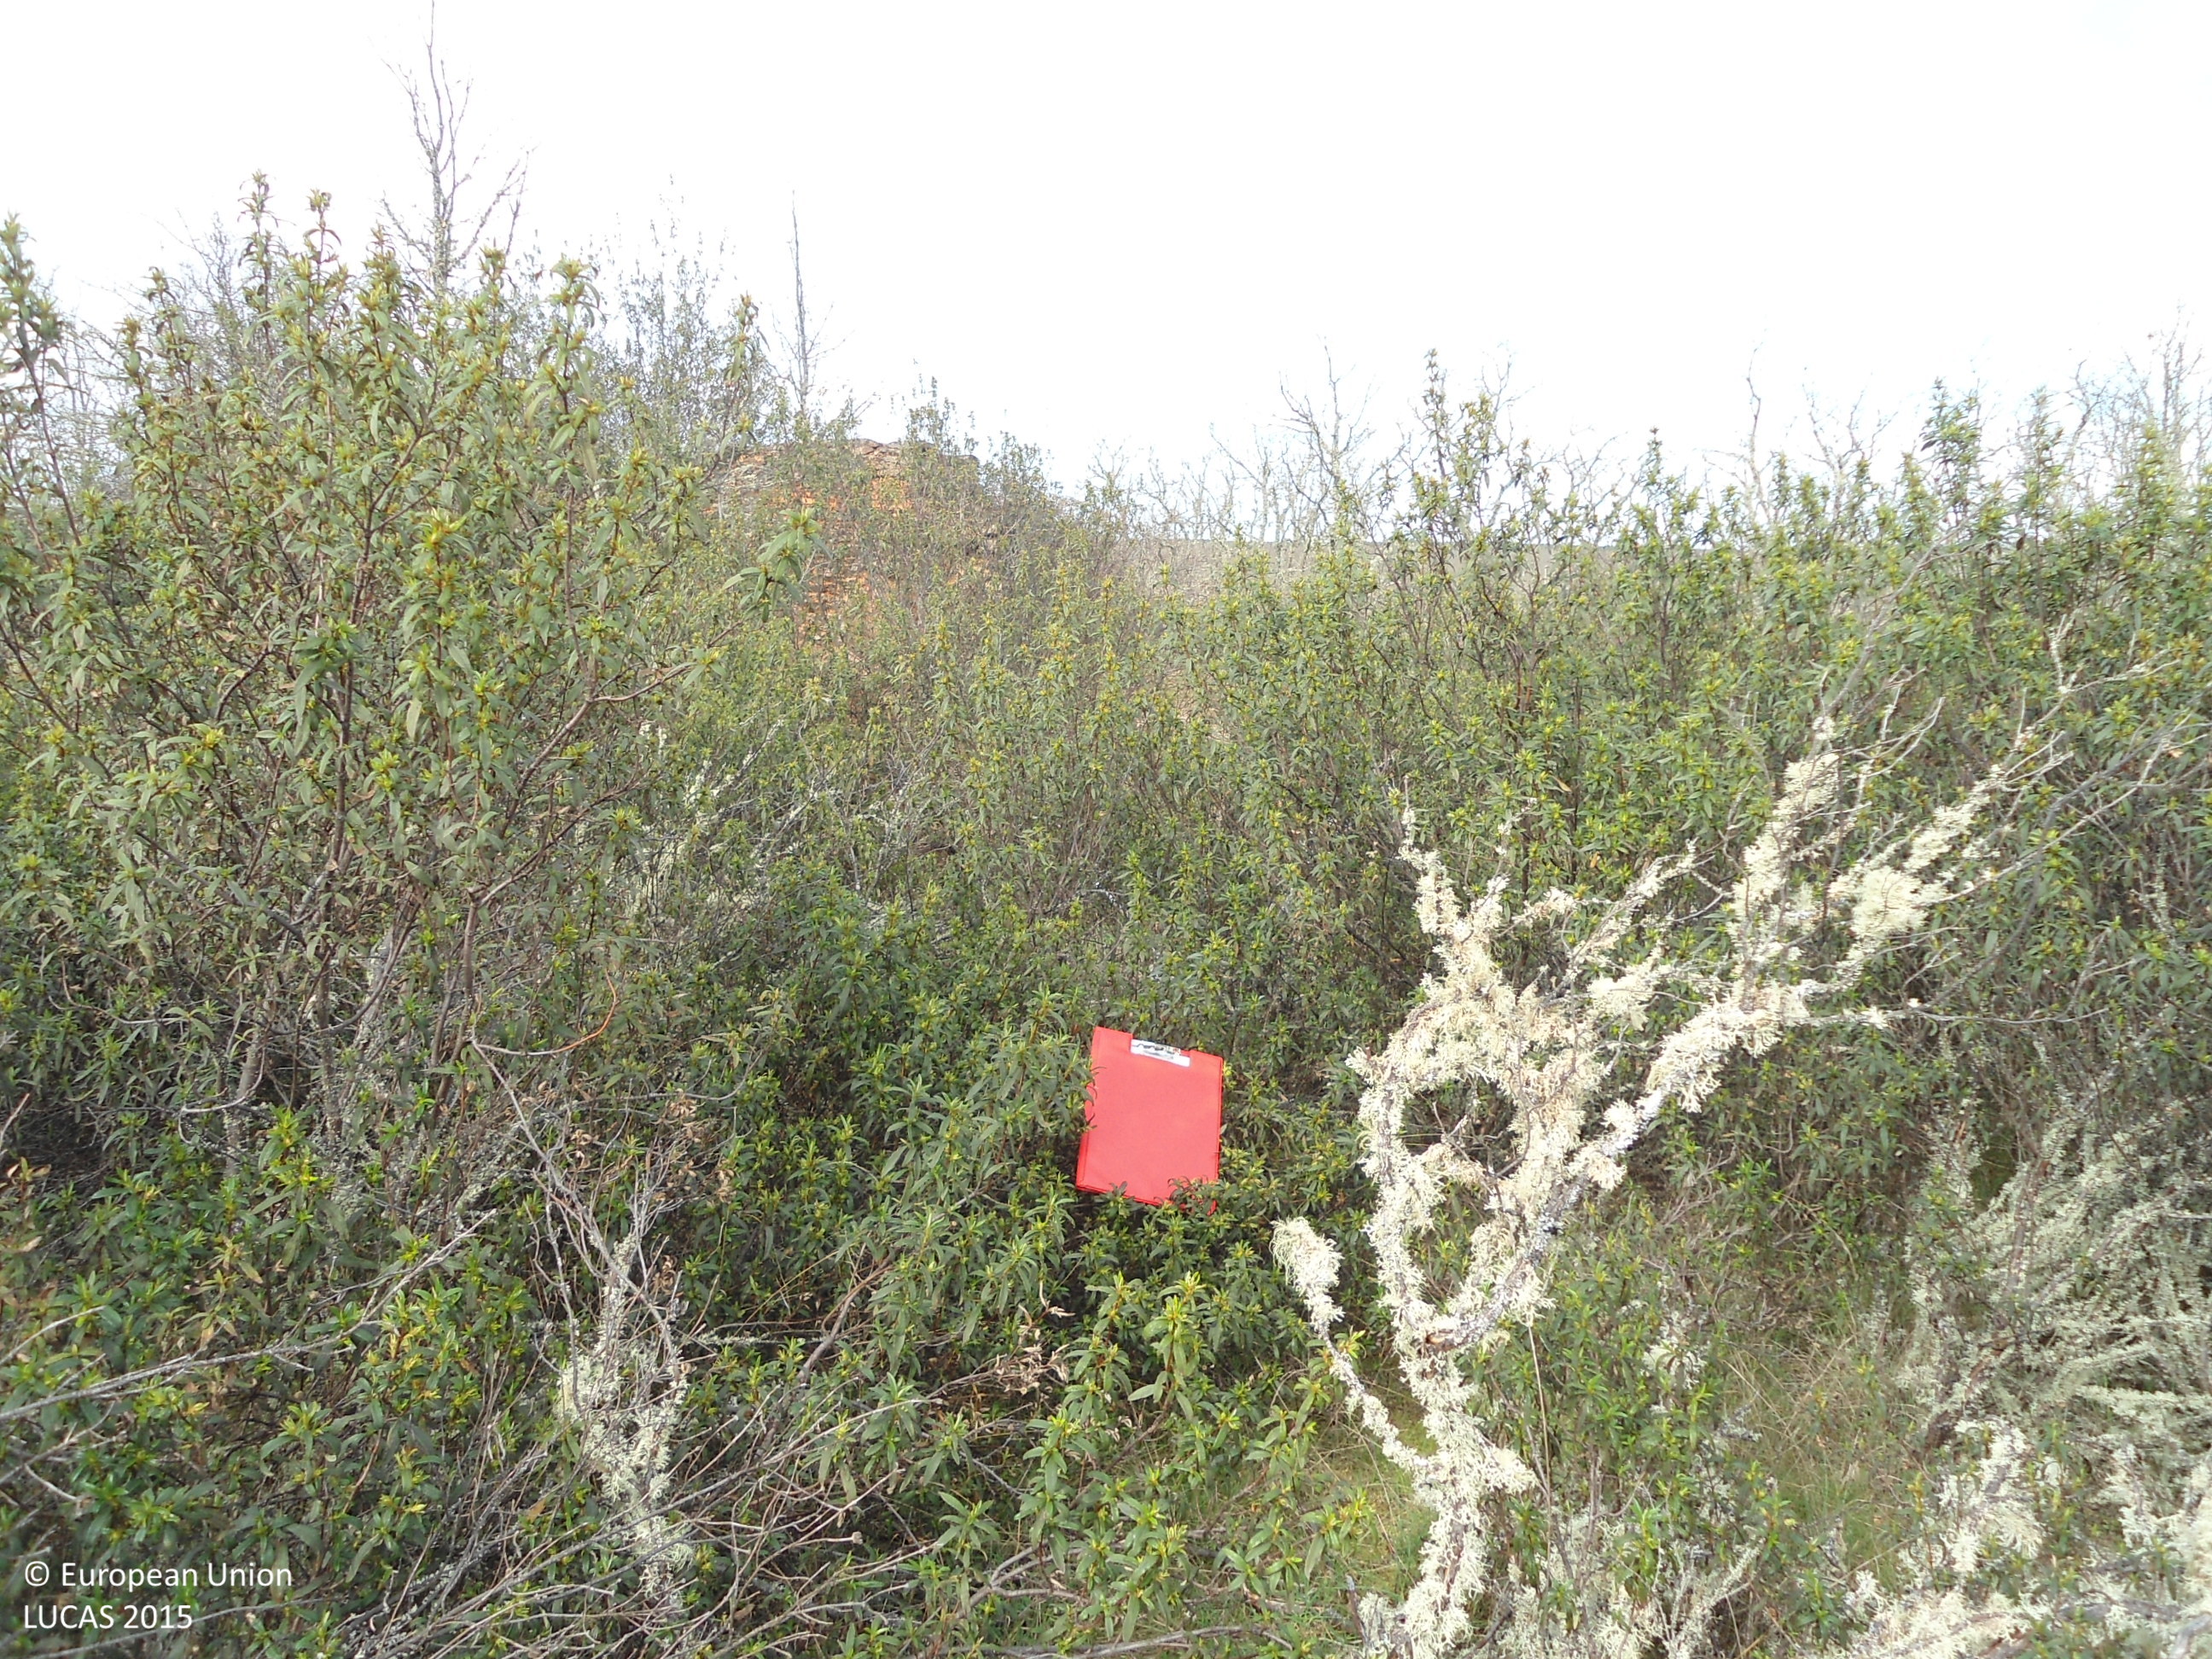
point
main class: Woodland
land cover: Broadleaved woodland
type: acidophilous oak and oak-birch forest
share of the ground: 25 - 50 %
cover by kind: broadleaved forest trees 50 %, shrubs 40 %, herbaceous plants 10 %
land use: Forestry
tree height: > 5 m
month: April
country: ES
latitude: 41.6660
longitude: -6.2287
